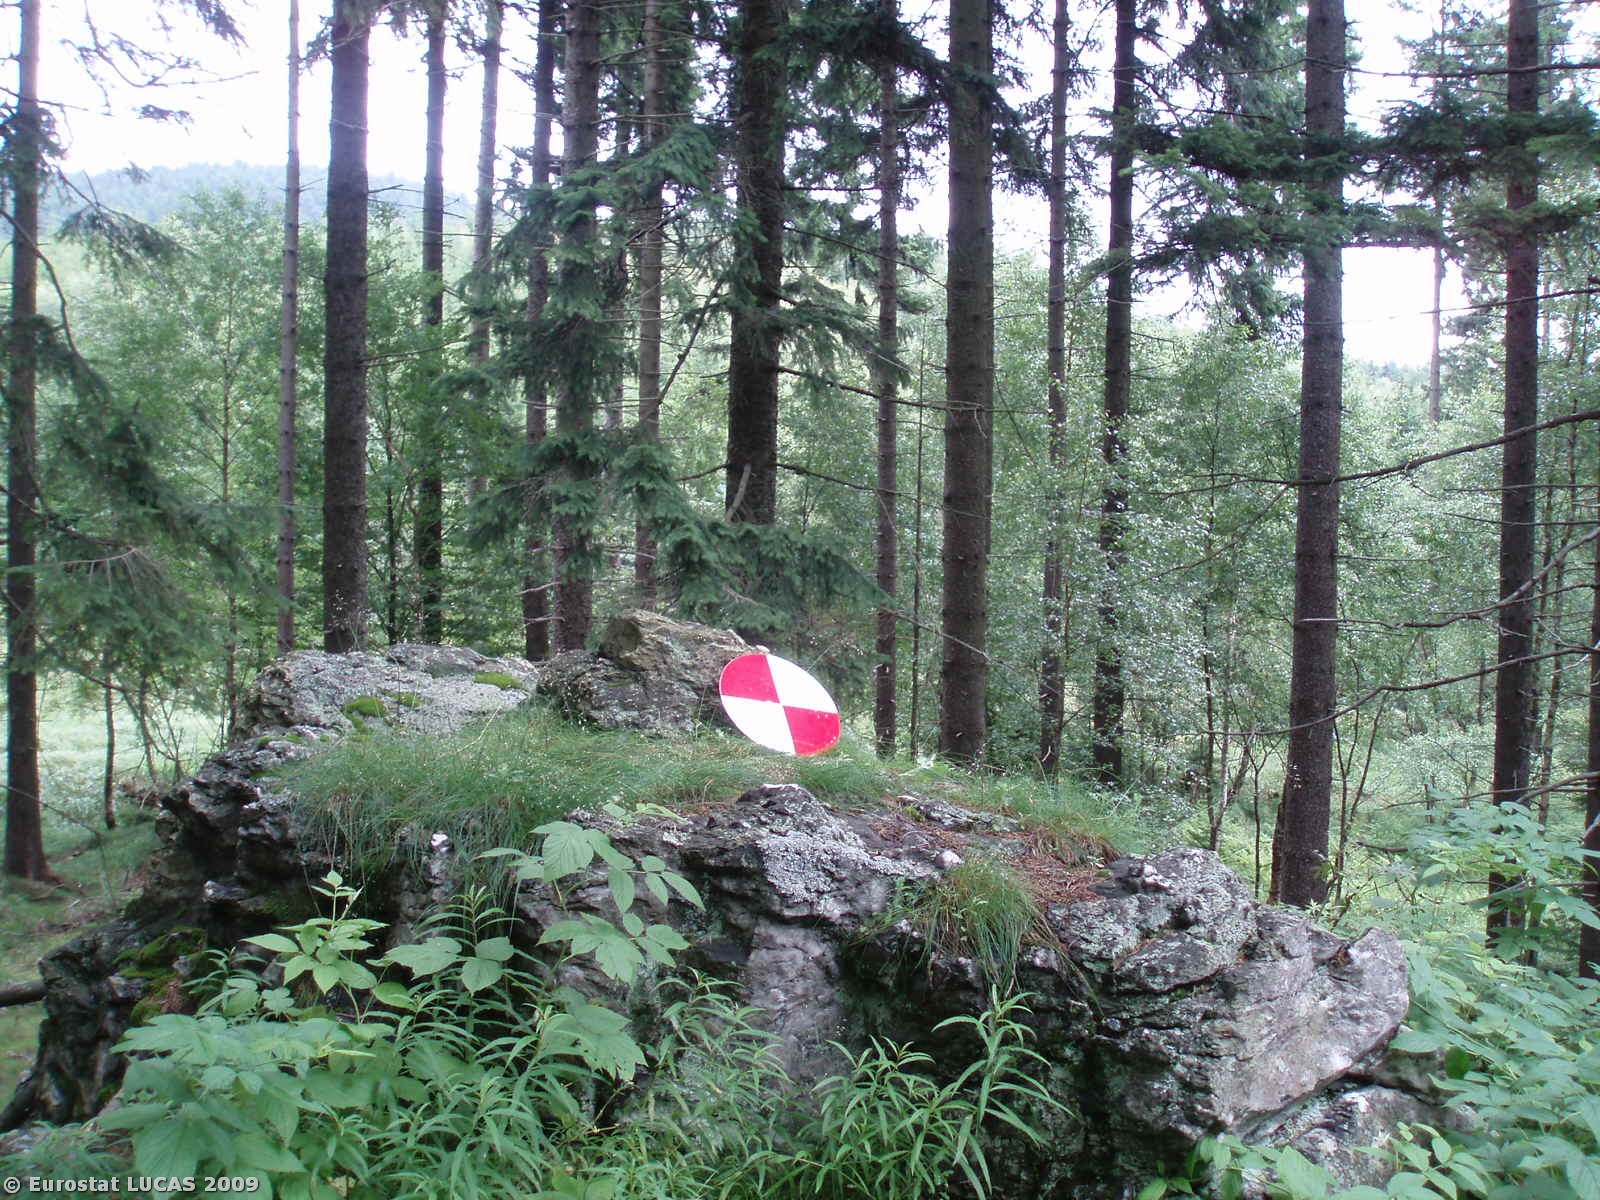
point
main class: Woodland
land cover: Coniferous woodland
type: hemiboreal forest and nemoral coniferous forest and mixed broadleaved-coniferous forest
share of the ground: > 75 %
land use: Forestry
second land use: Nature reserves
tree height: > 5 m
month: July
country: CZ
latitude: 50.7242
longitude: 14.9750
